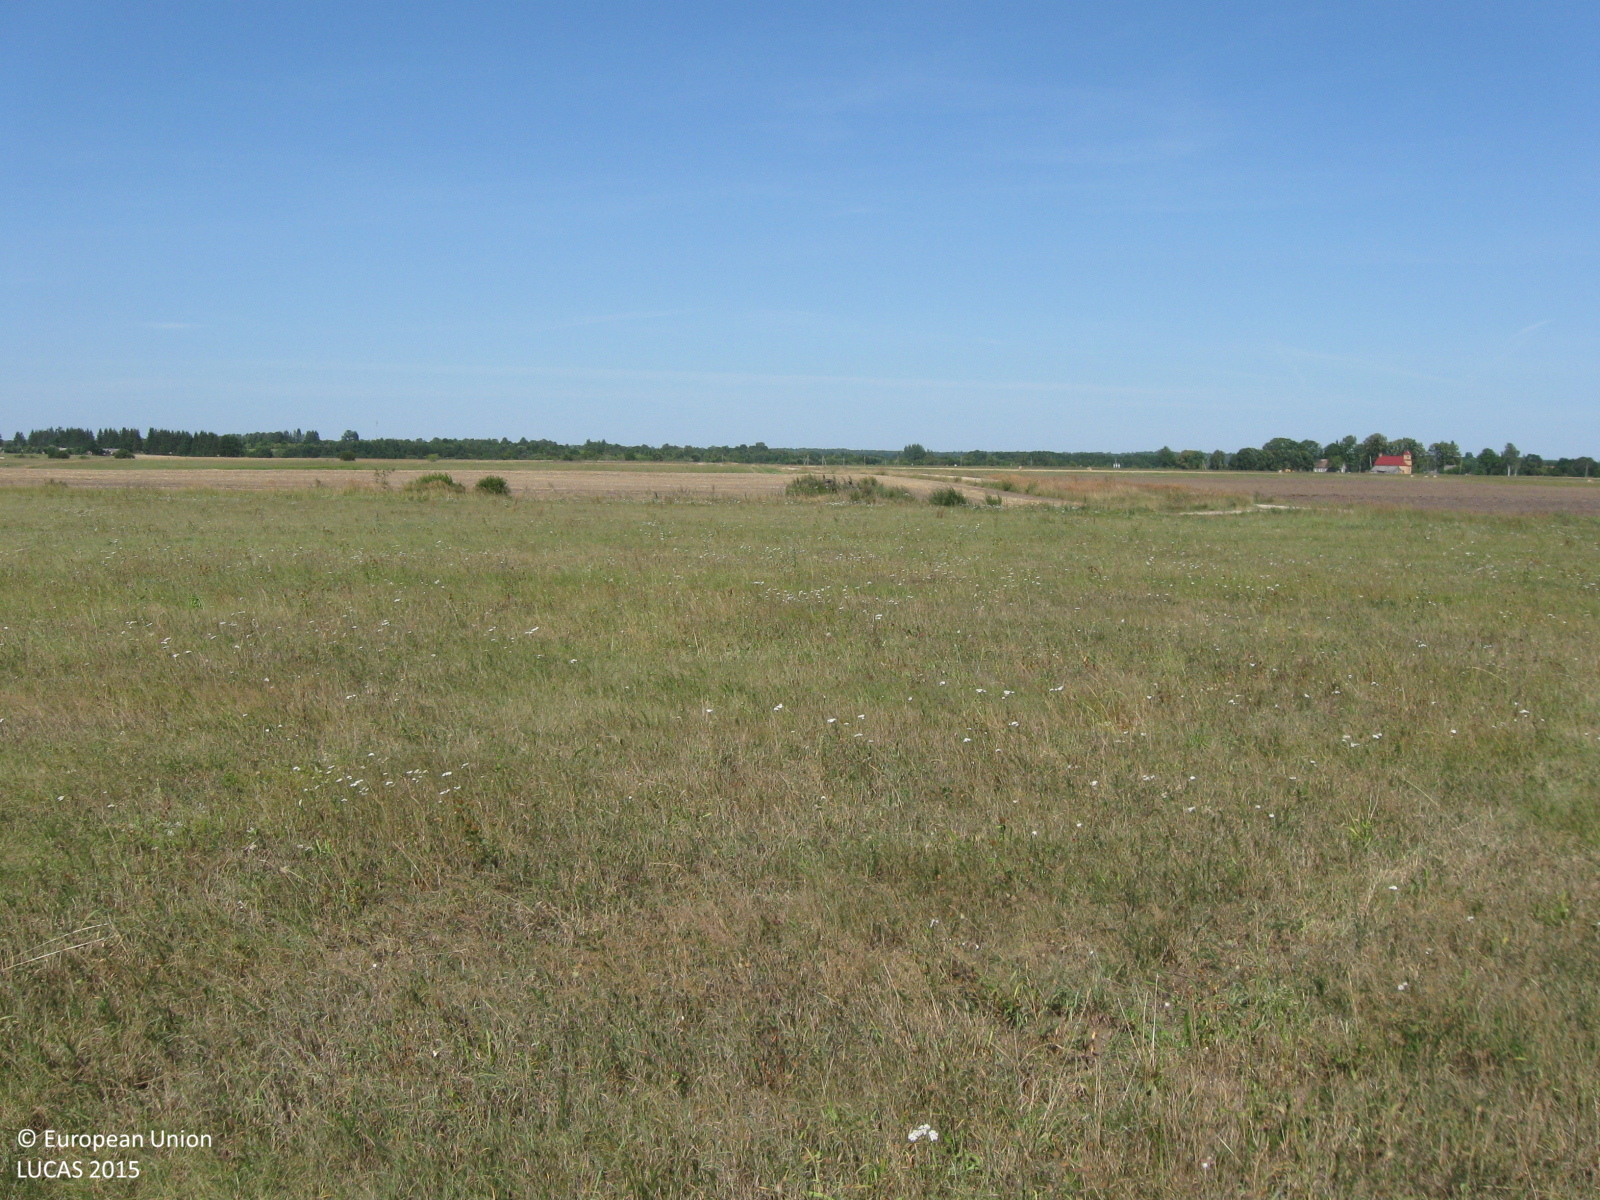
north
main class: Grassland
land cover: Grassland without tree/shrub cover
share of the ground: > 75 %
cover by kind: herbaceous plants 100 %
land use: Agriculture (excluding fallow land and kitchen gardens)
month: August
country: LT
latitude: 55.3367
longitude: 22.5005
